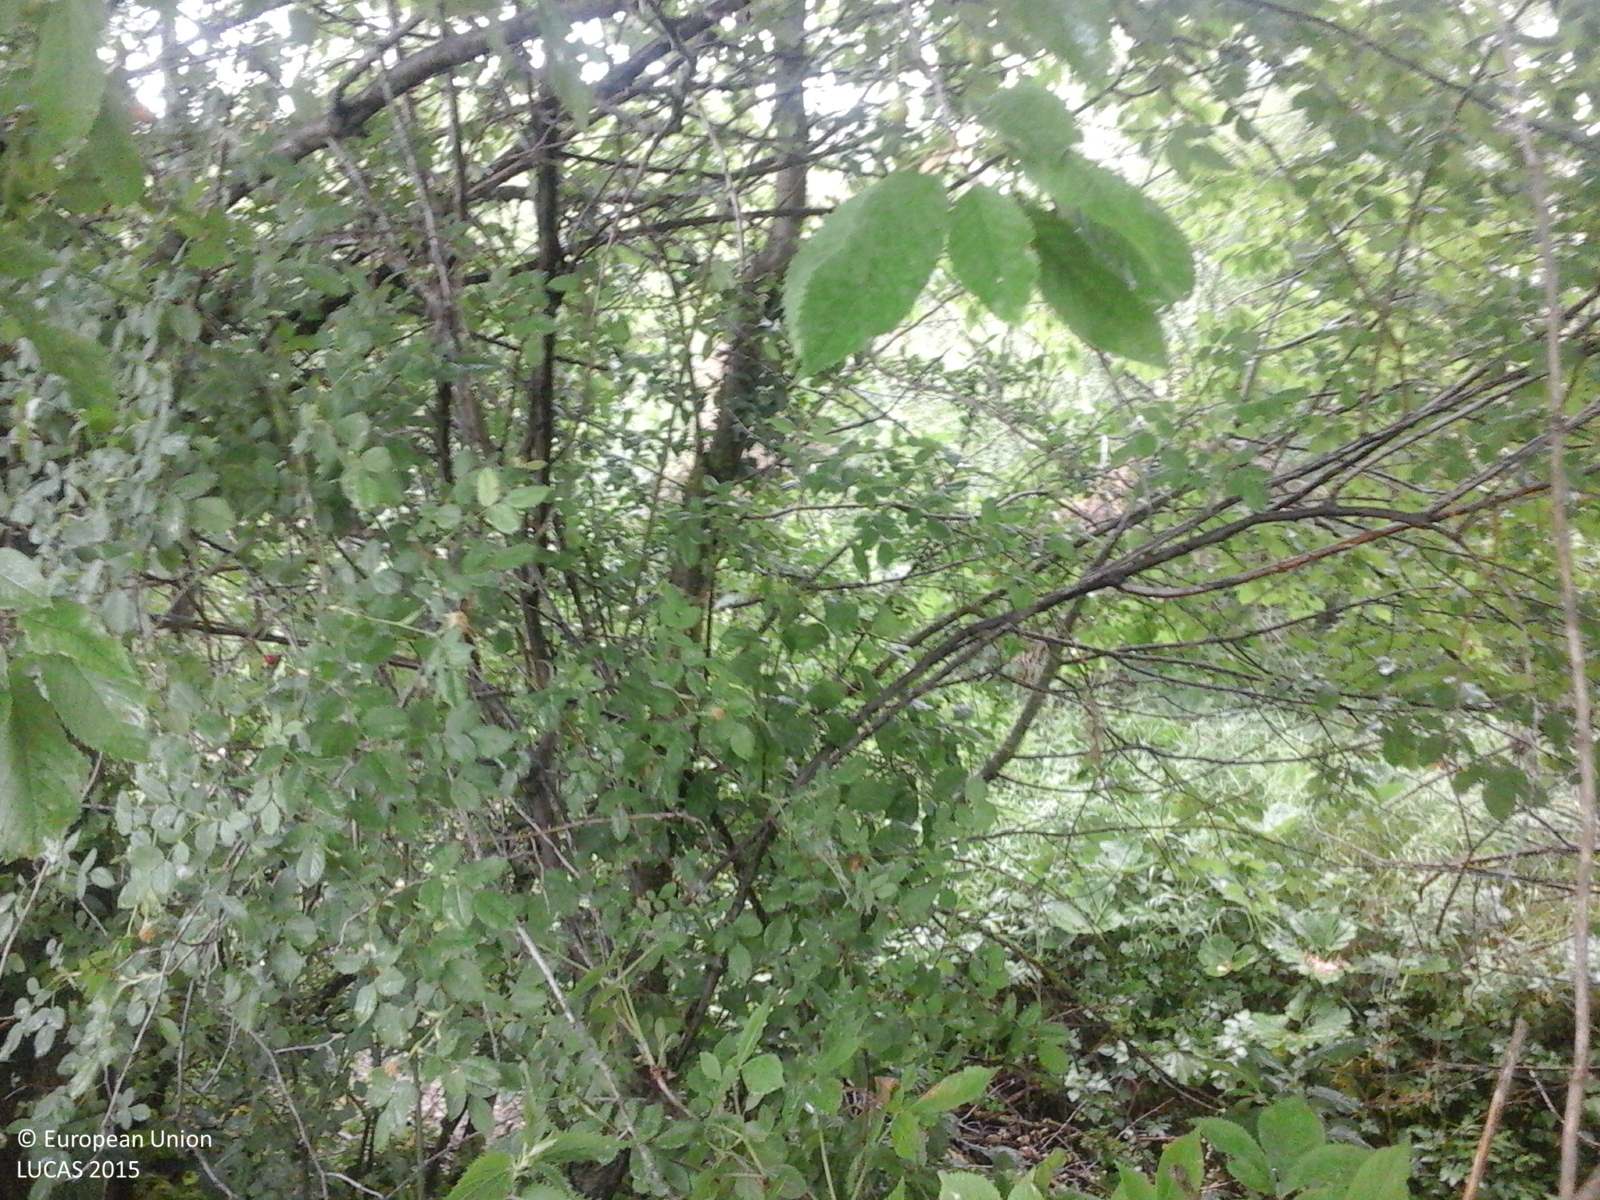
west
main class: Woodland
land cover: Broadleaved woodland
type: beech forest
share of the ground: > 75 %
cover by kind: broadleaved forest trees 100 %
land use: Forestry
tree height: > 5 m
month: June
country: RO
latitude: 47.2977
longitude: 26.3905
